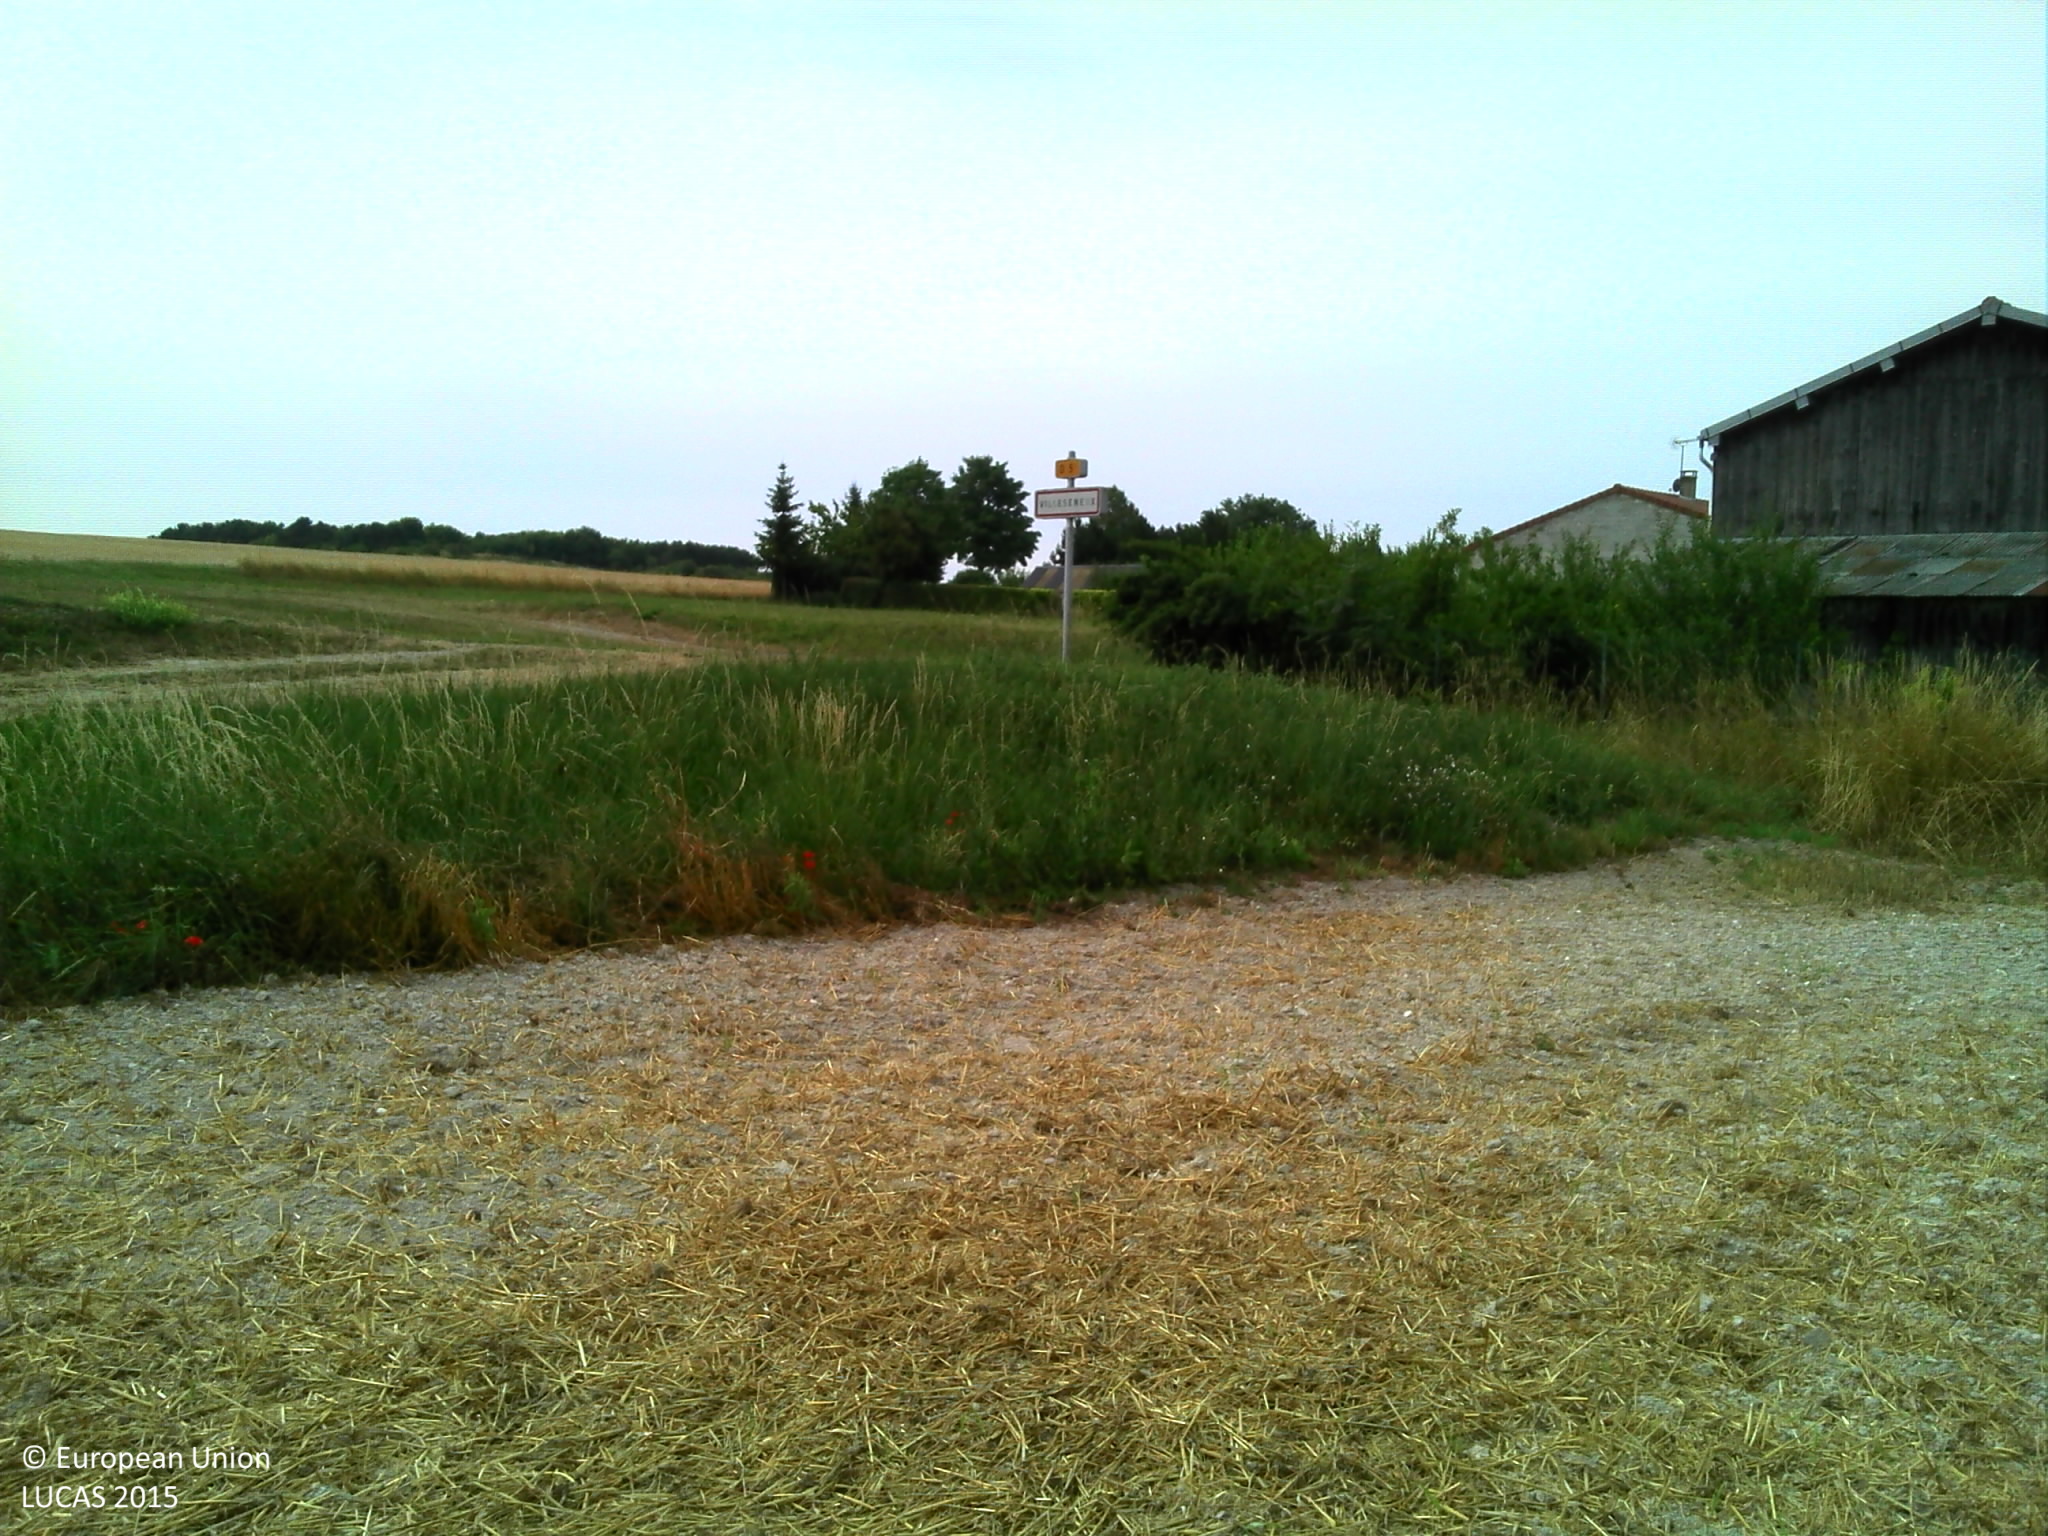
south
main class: Cropland
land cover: Barley
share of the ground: > 75 %
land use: Agriculture (excluding fallow land and kitchen gardens)
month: July
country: FR
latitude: 48.8439
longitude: 4.1501
